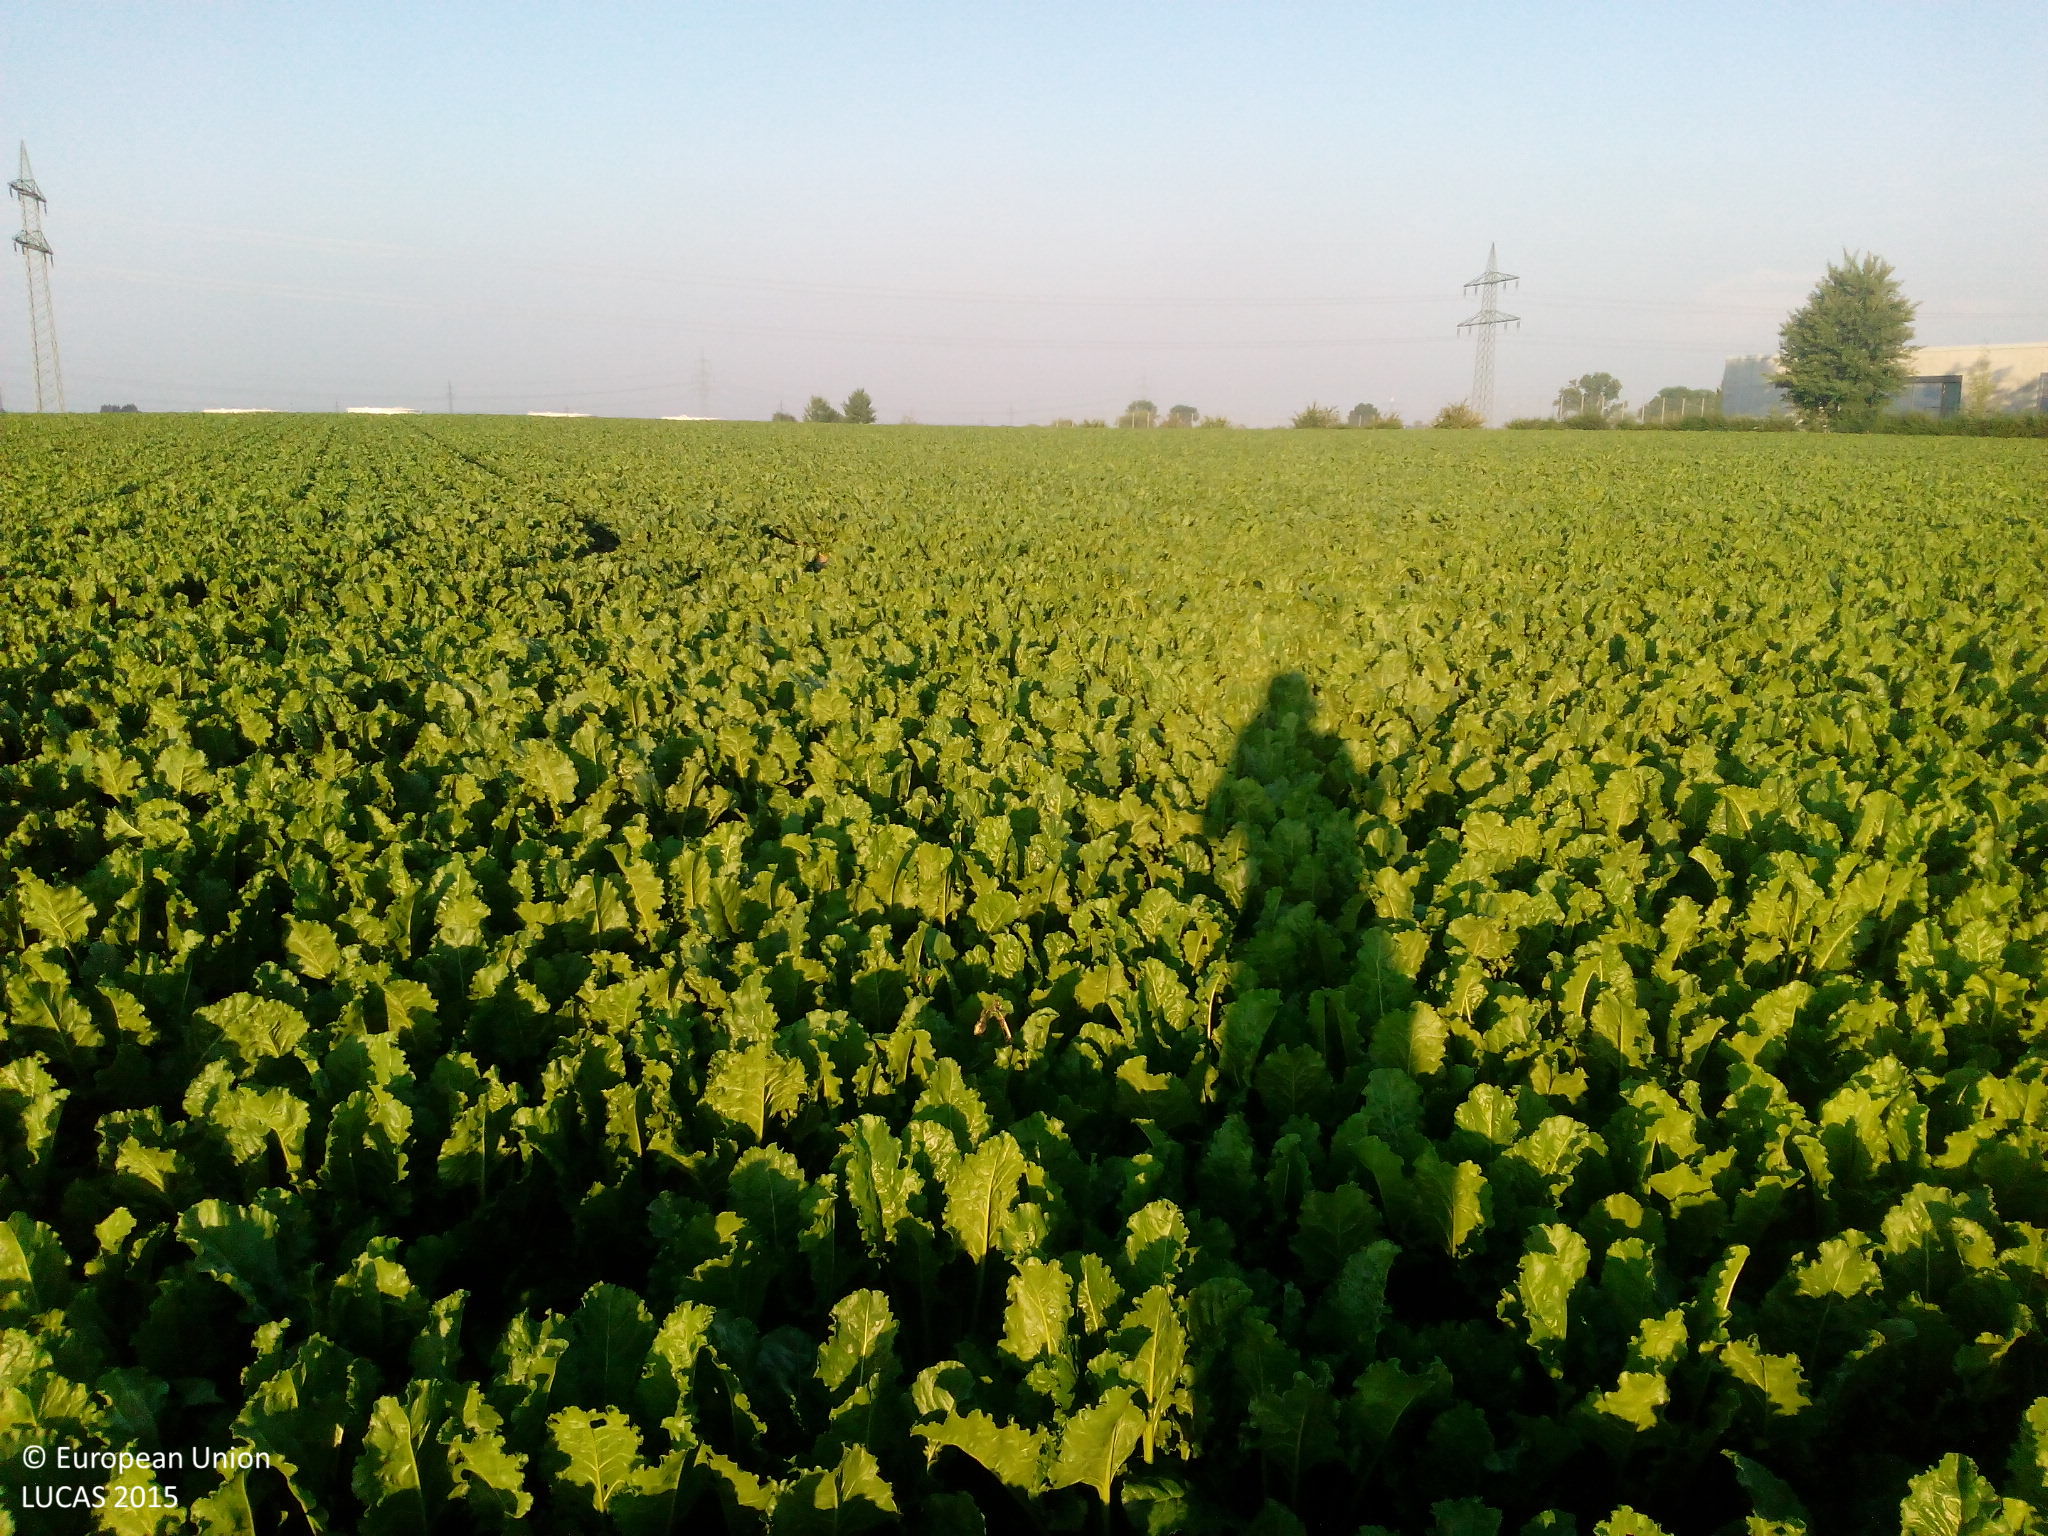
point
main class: Cropland
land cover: Sugar beet
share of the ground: > 75 %
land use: Agriculture (excluding fallow land and kitchen gardens)
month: July
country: DE
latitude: 48.8074
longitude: 11.4836
